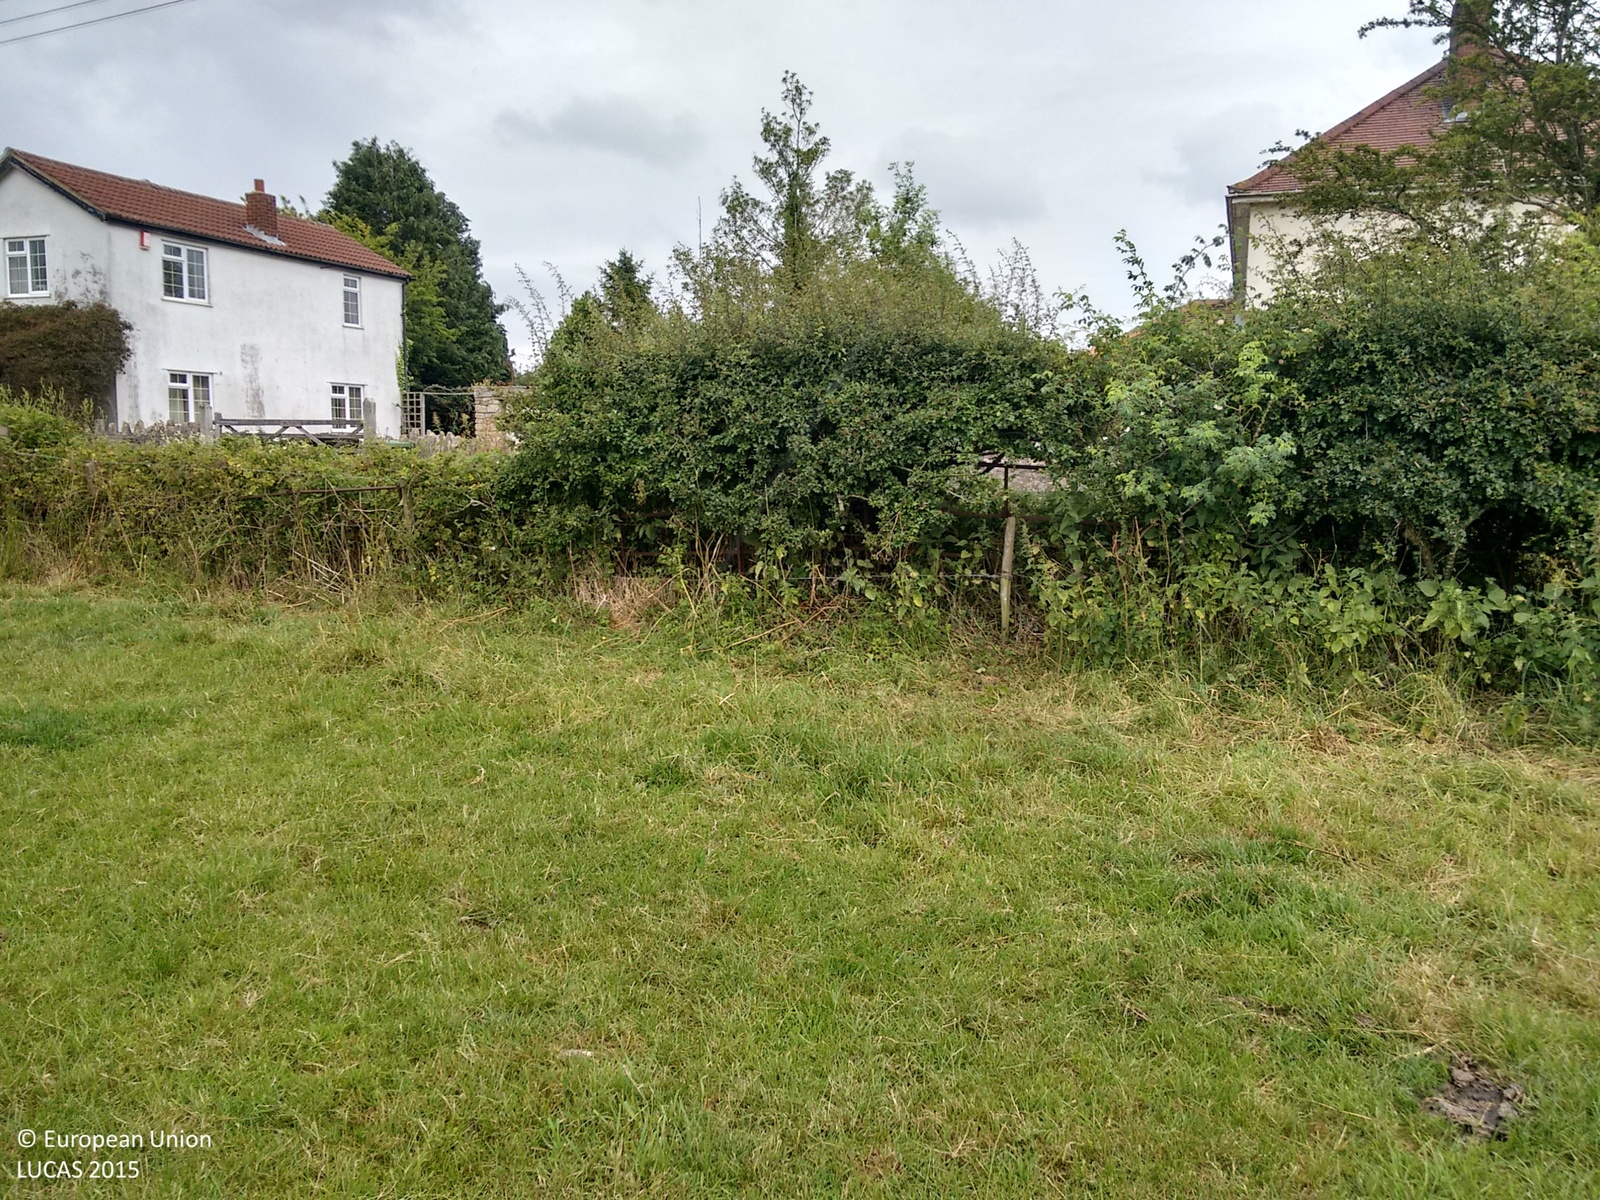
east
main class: Grassland
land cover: Grassland without tree/shrub cover
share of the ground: > 75 %
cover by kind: herbaceous plants 100 %
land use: Agriculture (excluding fallow land and kitchen gardens)
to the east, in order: Grassland without tree/shrub cover; Fences; Managed hedges; Electric lines; Paved roads, cycling and walking lanes; Electric lines; Paved roads, cycling and walking lanes; Grass margins; Artificial constructions in urban areas; Grassland without tree/shrub cover; Fences; Managed hedges; Grassland without tree/shrub cover; Fences; Broadleaved woodland; Tracks; Broadleaved woodland; Fences; Broadleaved woodland
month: July
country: GB
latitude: 51.2242
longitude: -2.4806
